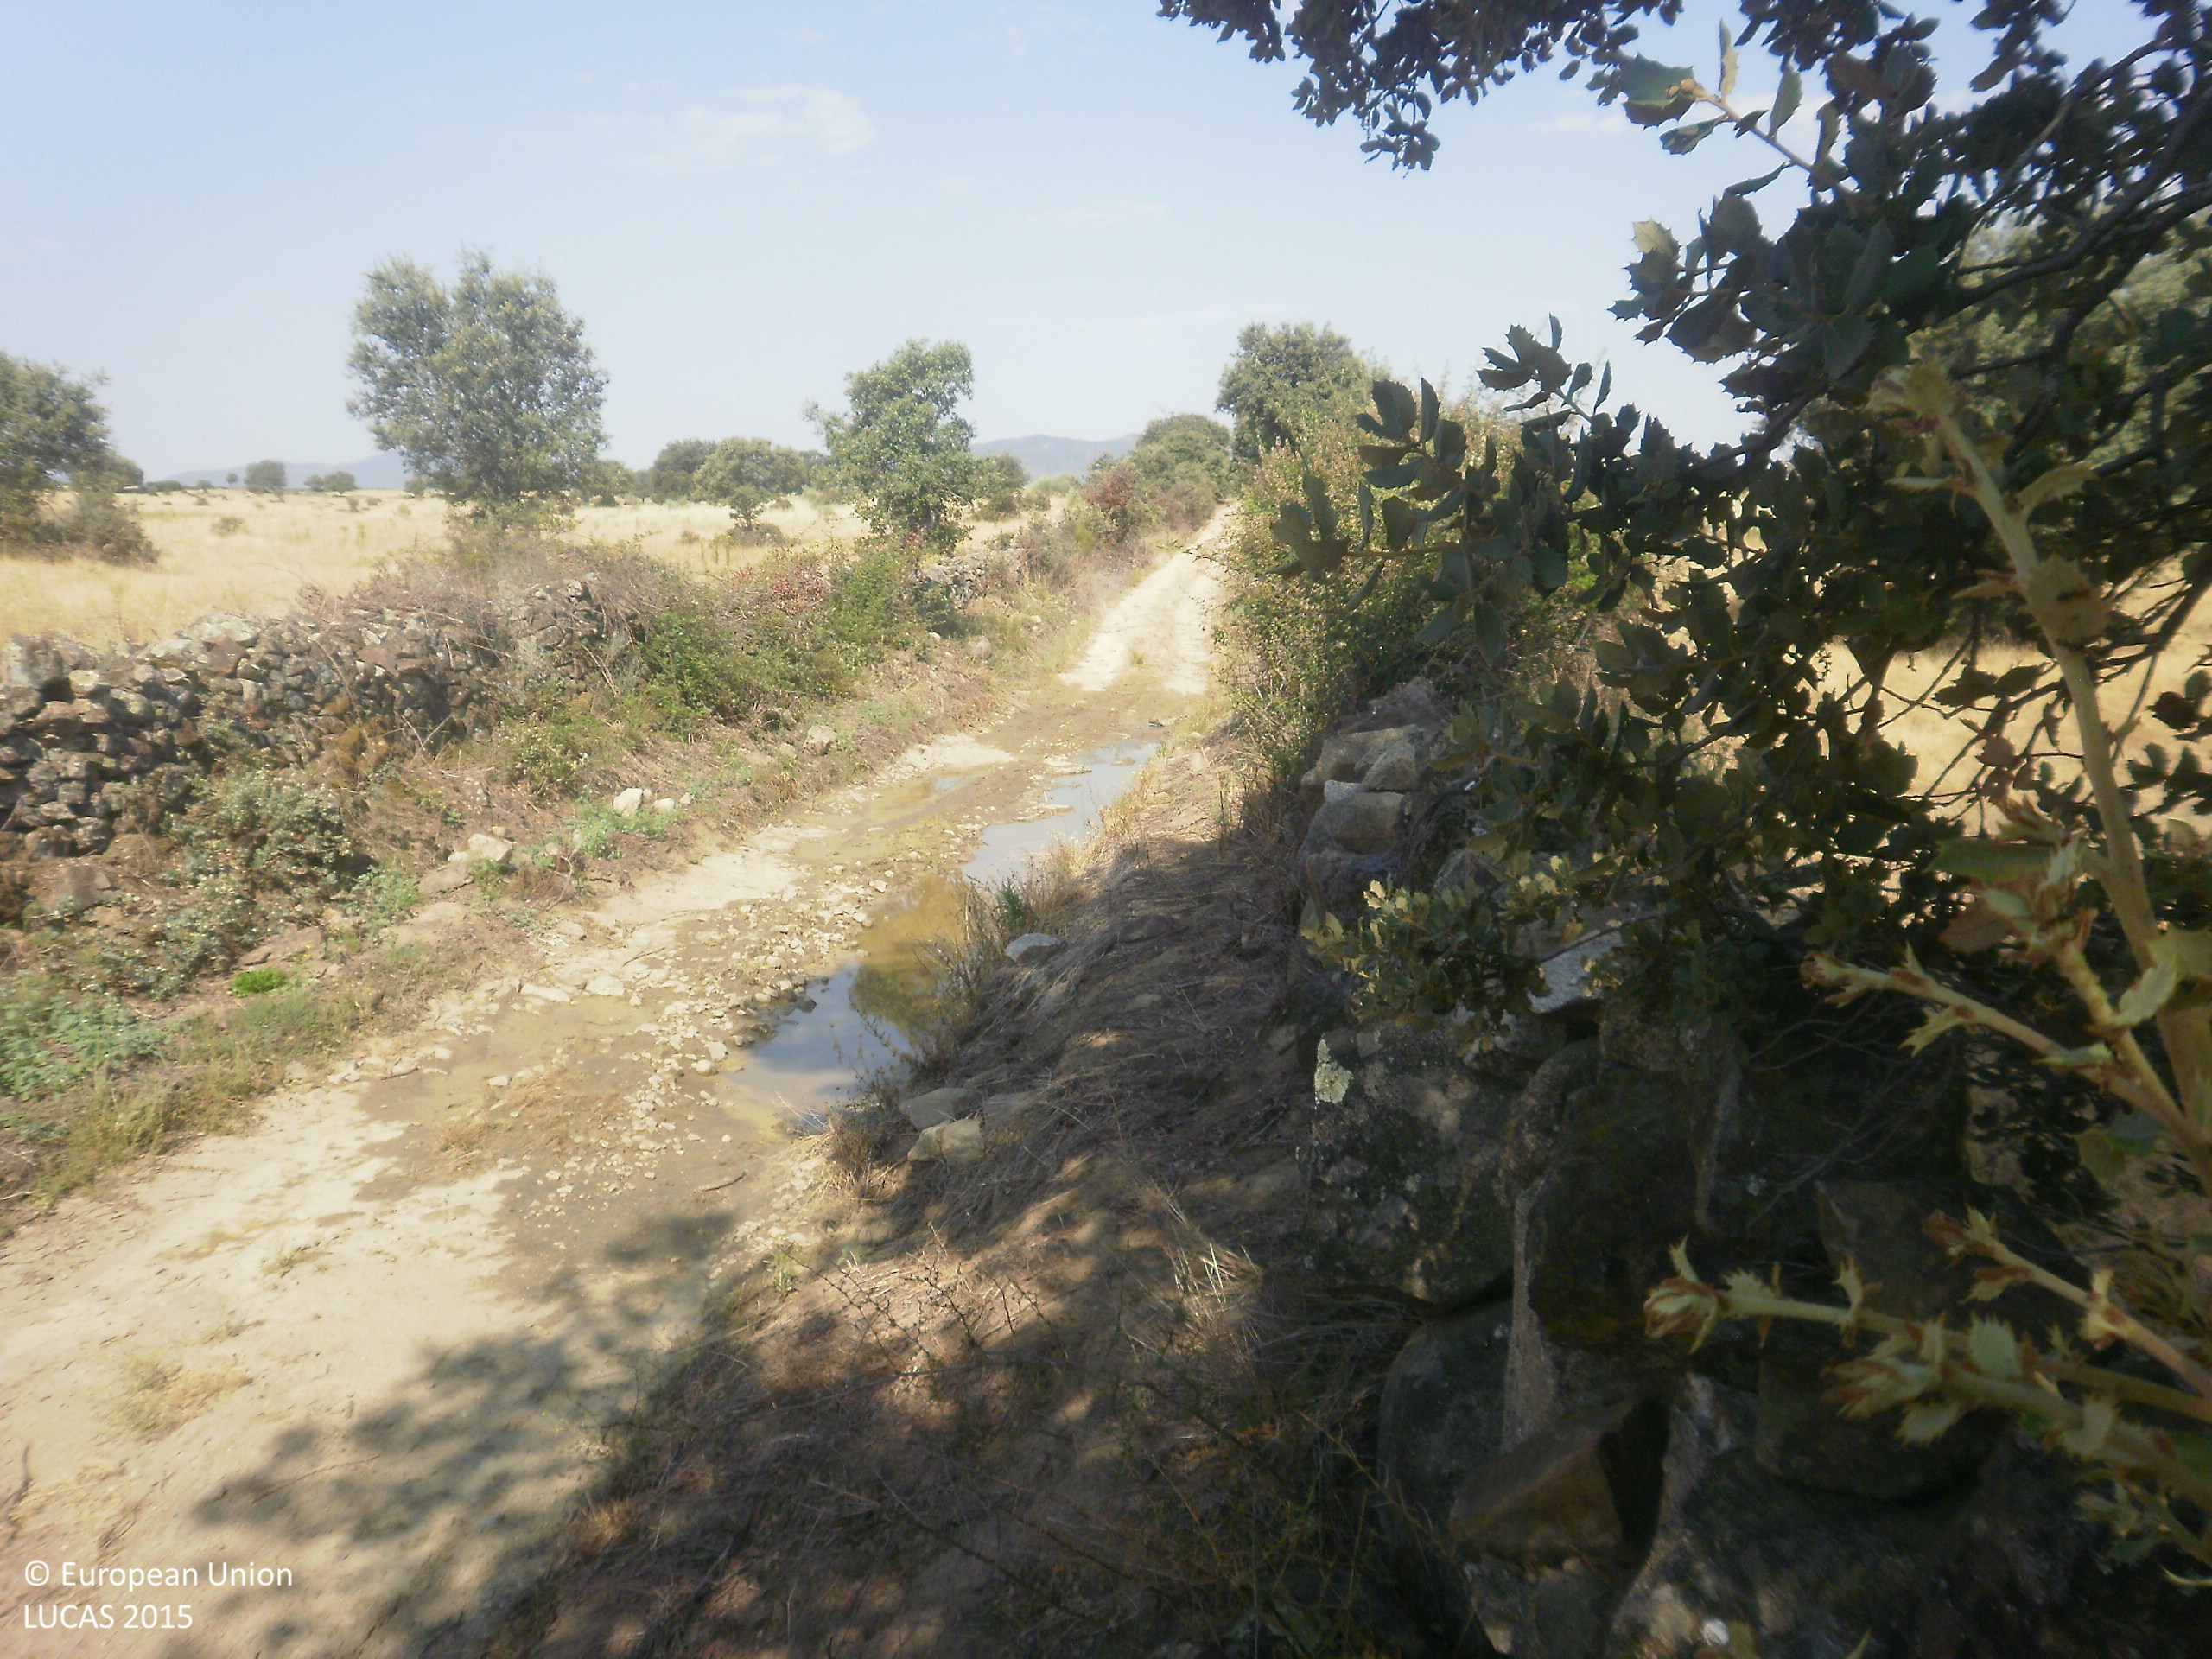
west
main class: Woodland
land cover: Broadleaved woodland
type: broadleaved evergreen forest
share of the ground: 10 - 25 %
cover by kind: herbaceous plants 80 %, broadleaved forest trees 15 %, shrubs 5 %
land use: Forestry
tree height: > 5 m
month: June
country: ES
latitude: 39.2563
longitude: -5.8967
